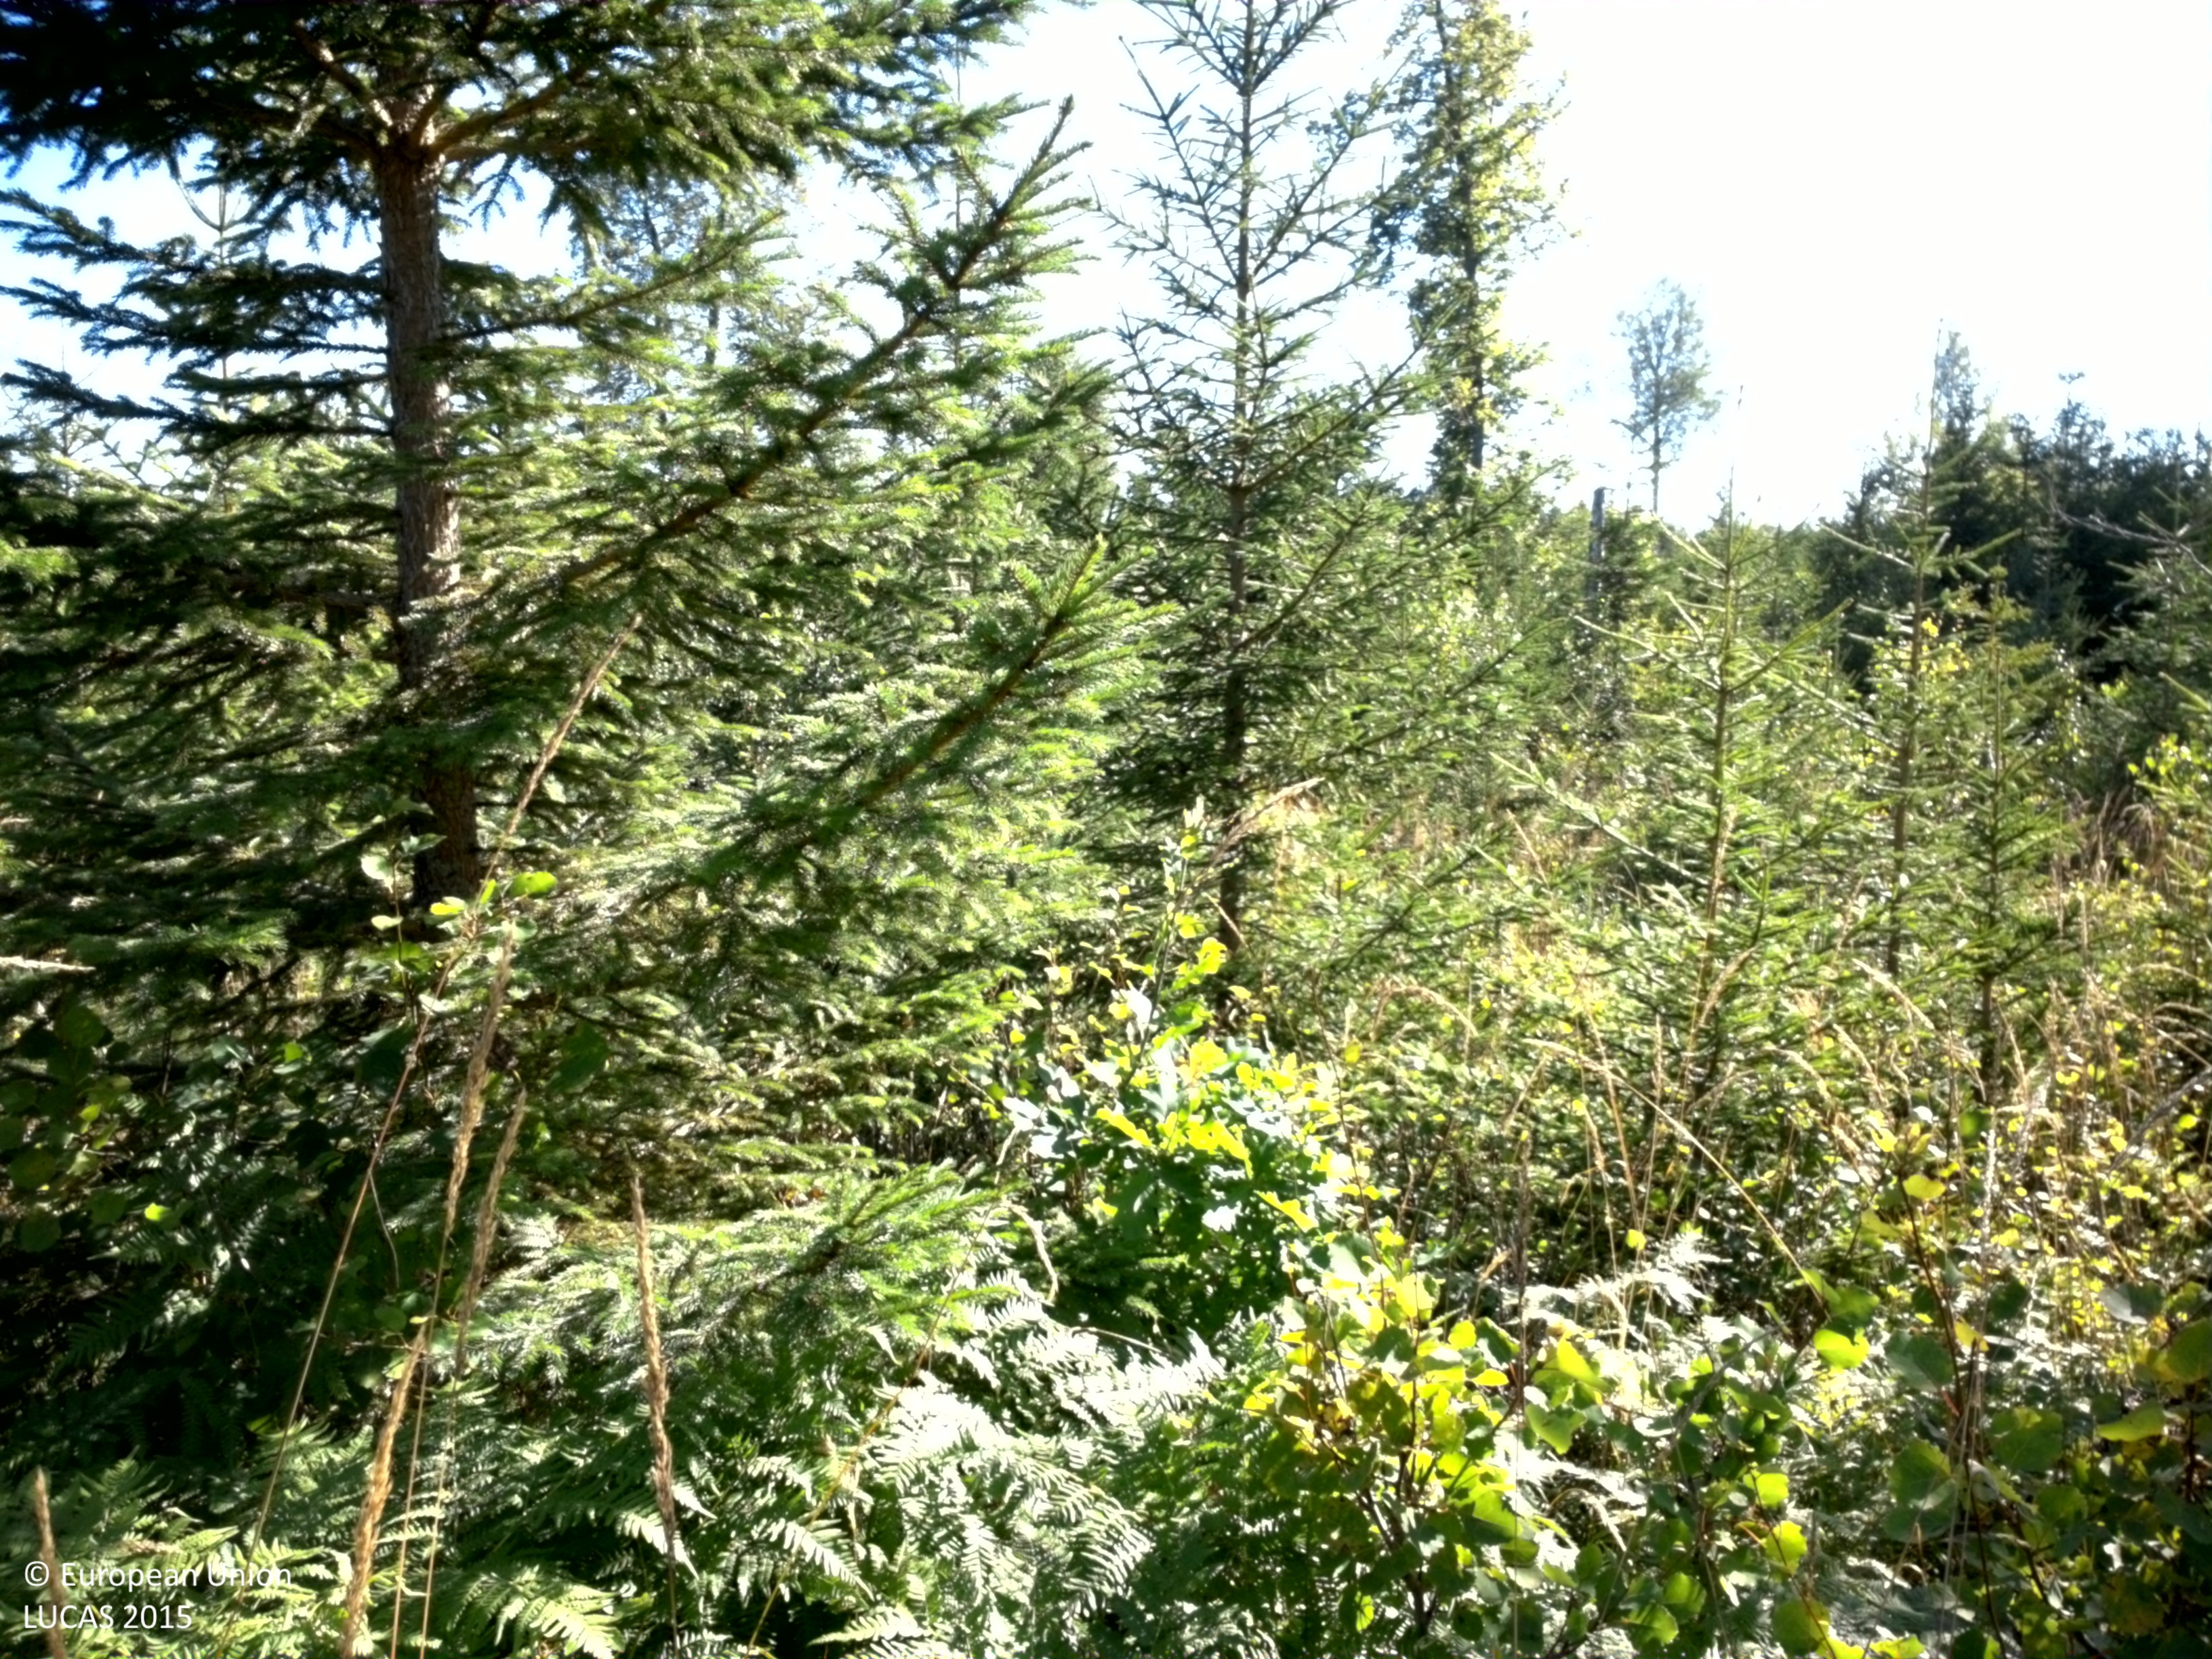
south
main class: Woodland
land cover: Spruce dominated coniferous woodland
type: boreal forest
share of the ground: 25 - 50 %
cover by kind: herbaceous plants 60 %, coniferous forest trees 25 %, shrubs 10 %, broadleaved forest trees 5 %
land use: Forestry
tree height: < 5 m
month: August
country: SE
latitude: 59.9555
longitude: 17.9635
